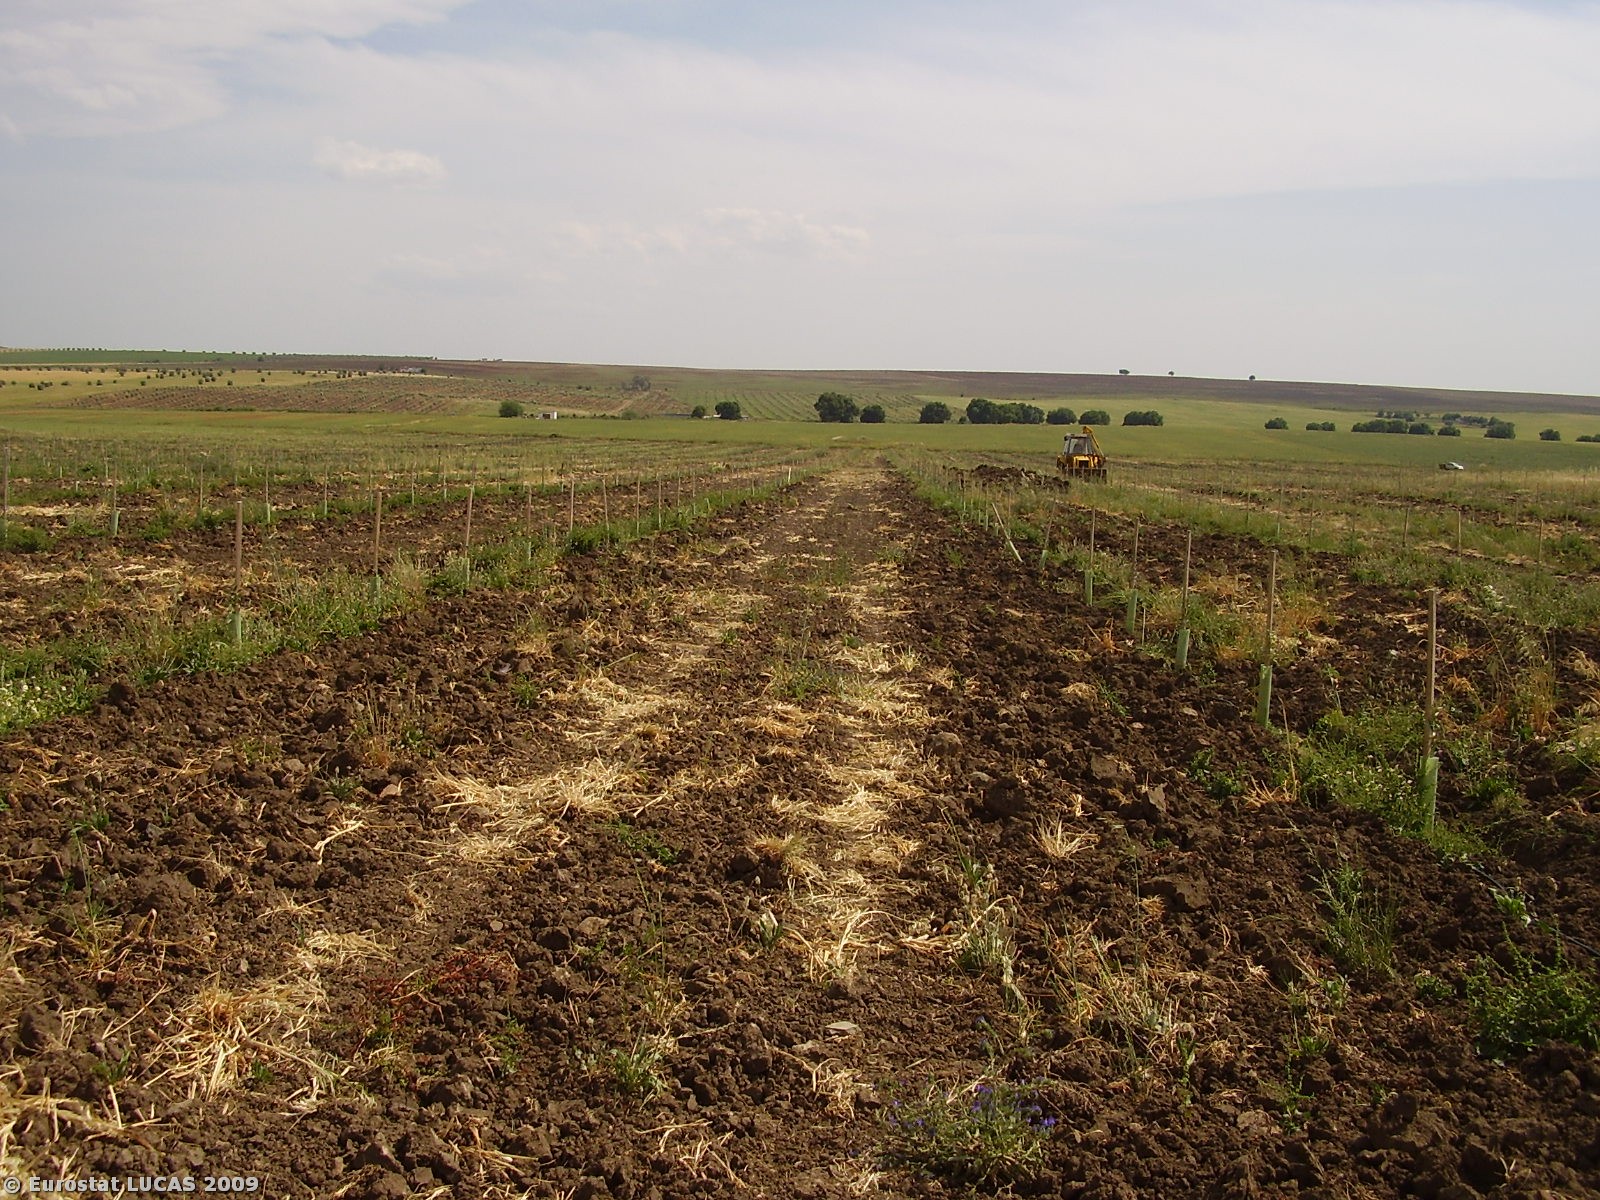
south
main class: Cropland
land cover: Olive groves
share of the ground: 50 - 75 %
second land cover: Bare land
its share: 25 - 50 %
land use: Agriculture (excluding fallow land and kitchen gardens)
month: May
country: PT
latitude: 37.9826
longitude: -7.7746
